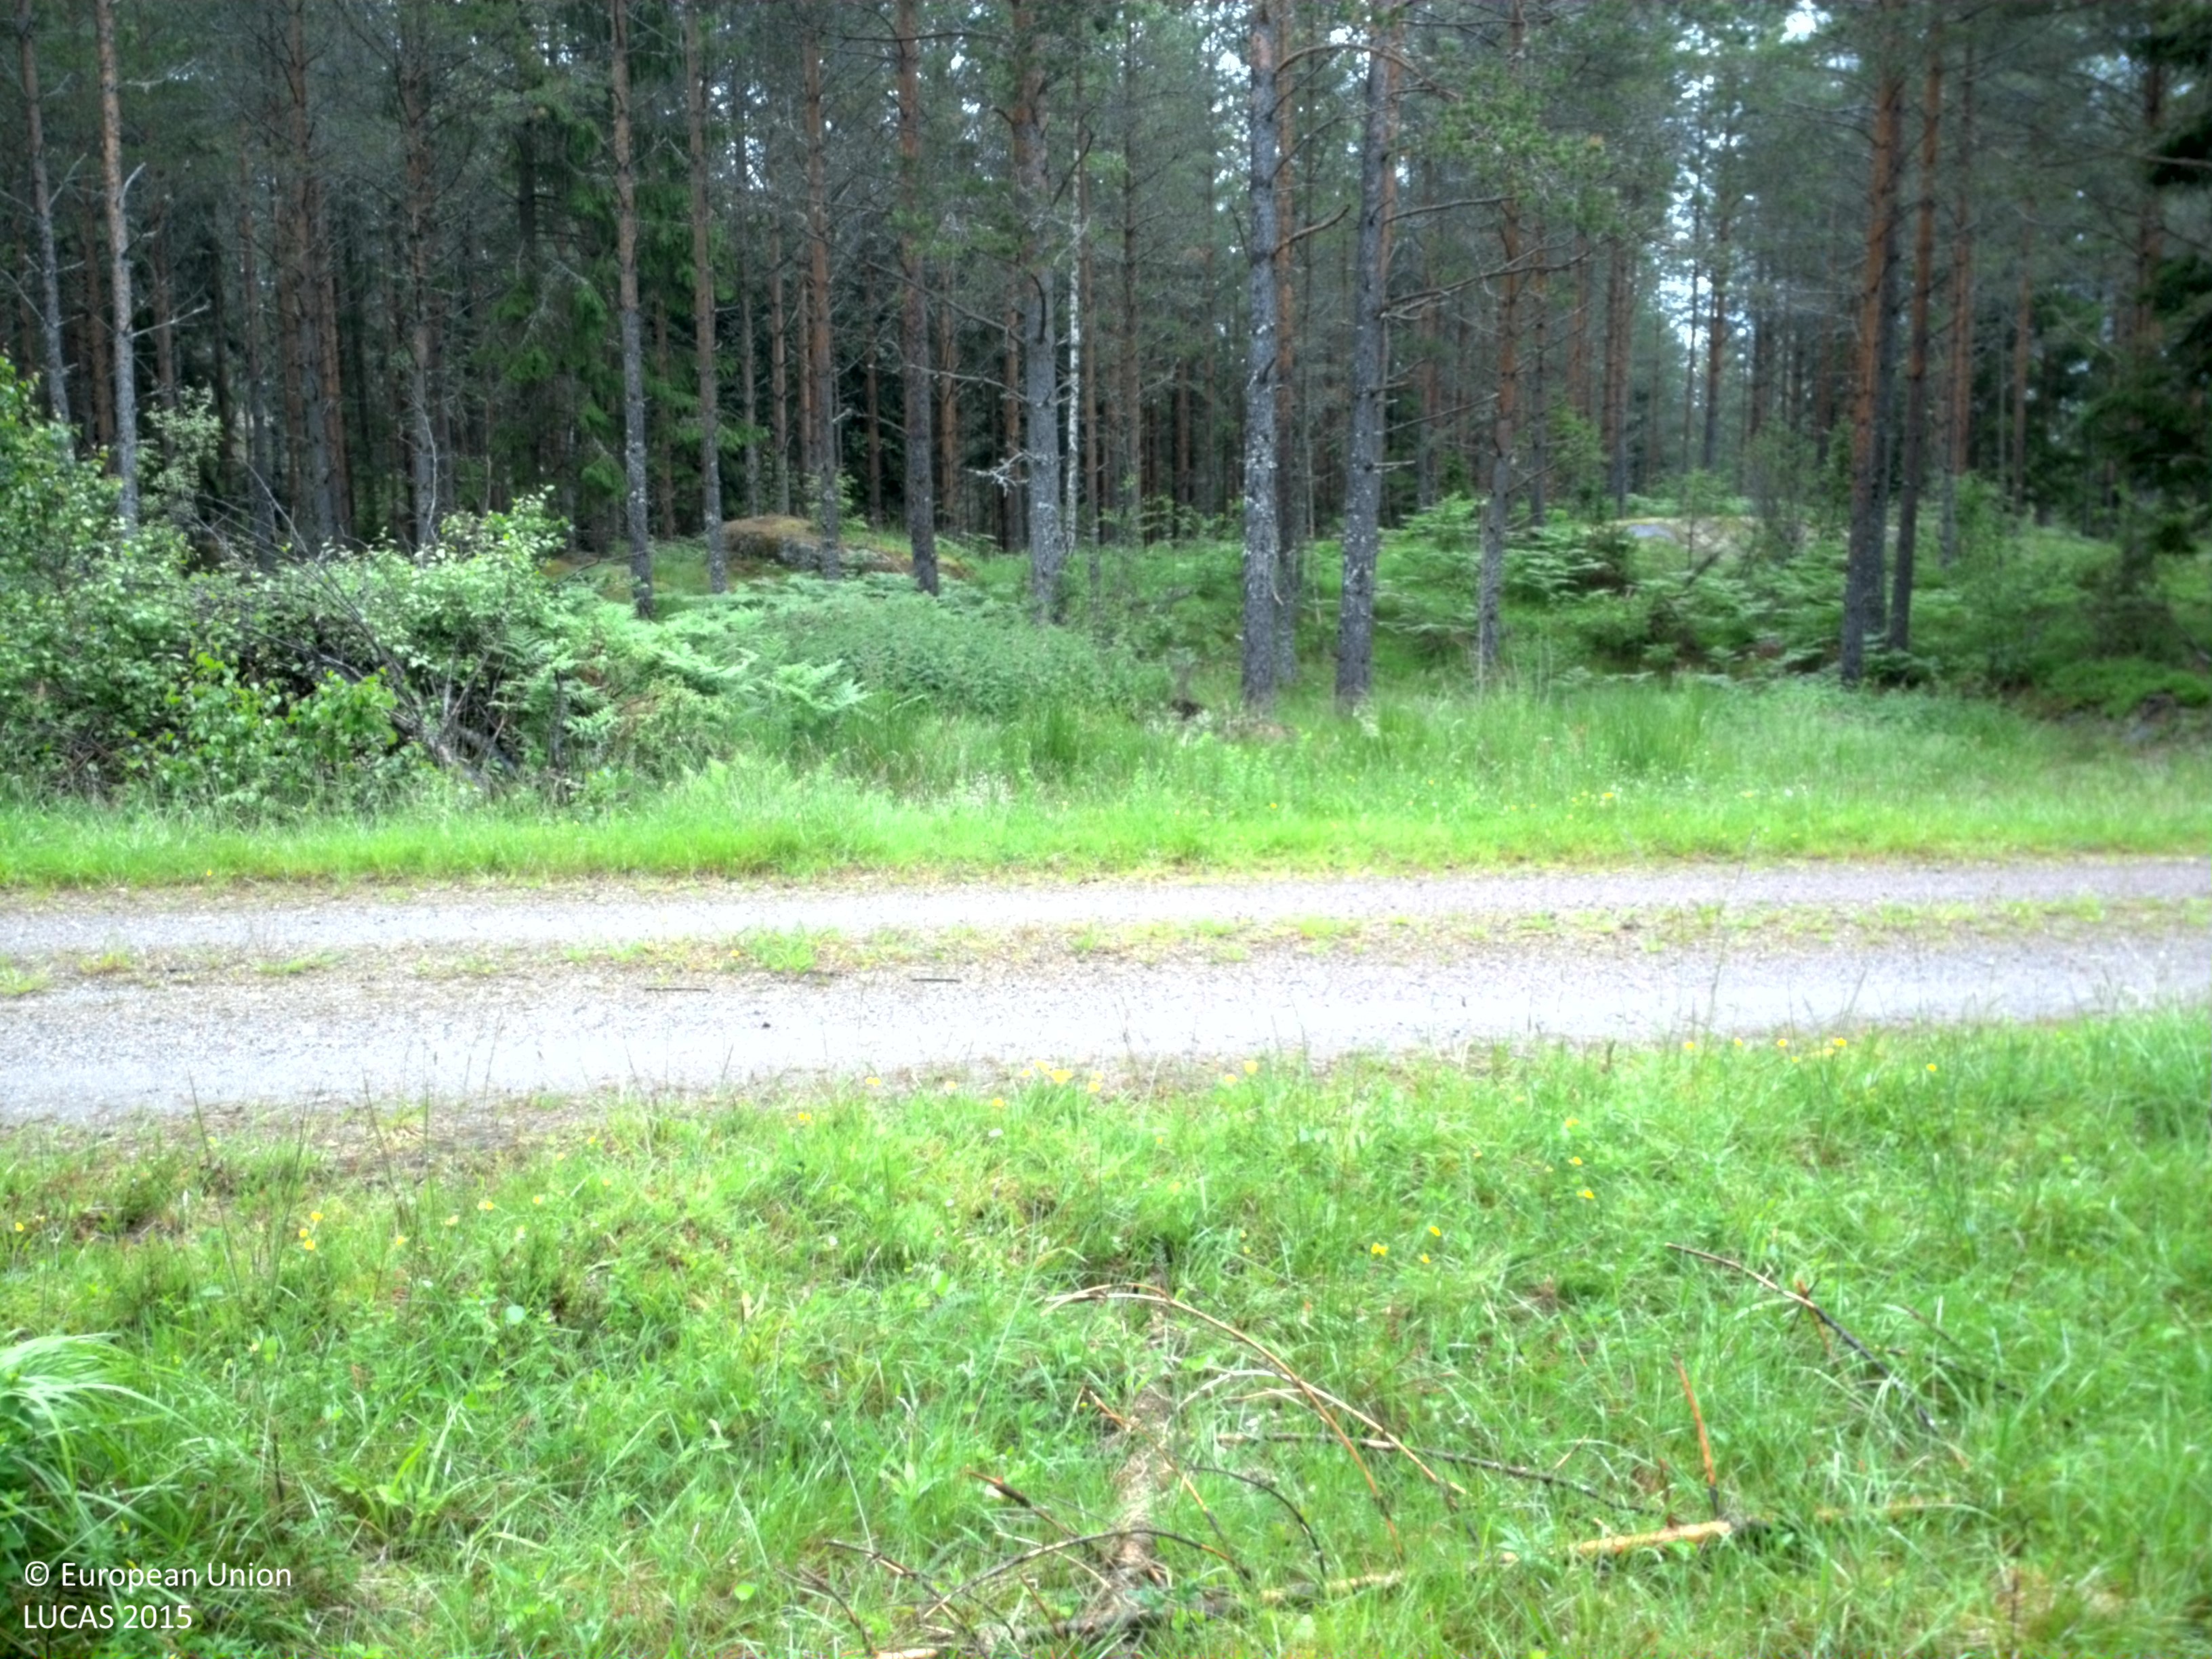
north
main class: Woodland
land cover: Pine dominated mixed woodland
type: boreal forest
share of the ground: 25 - 50 %
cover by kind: herbaceous plants 45 %, coniferous forest trees 30 %, broadleaved forest trees 15 %, lichens and mosses 10 %
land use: Forestry
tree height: > 5 m
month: June
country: SE
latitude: 58.6677
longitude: 15.4592
